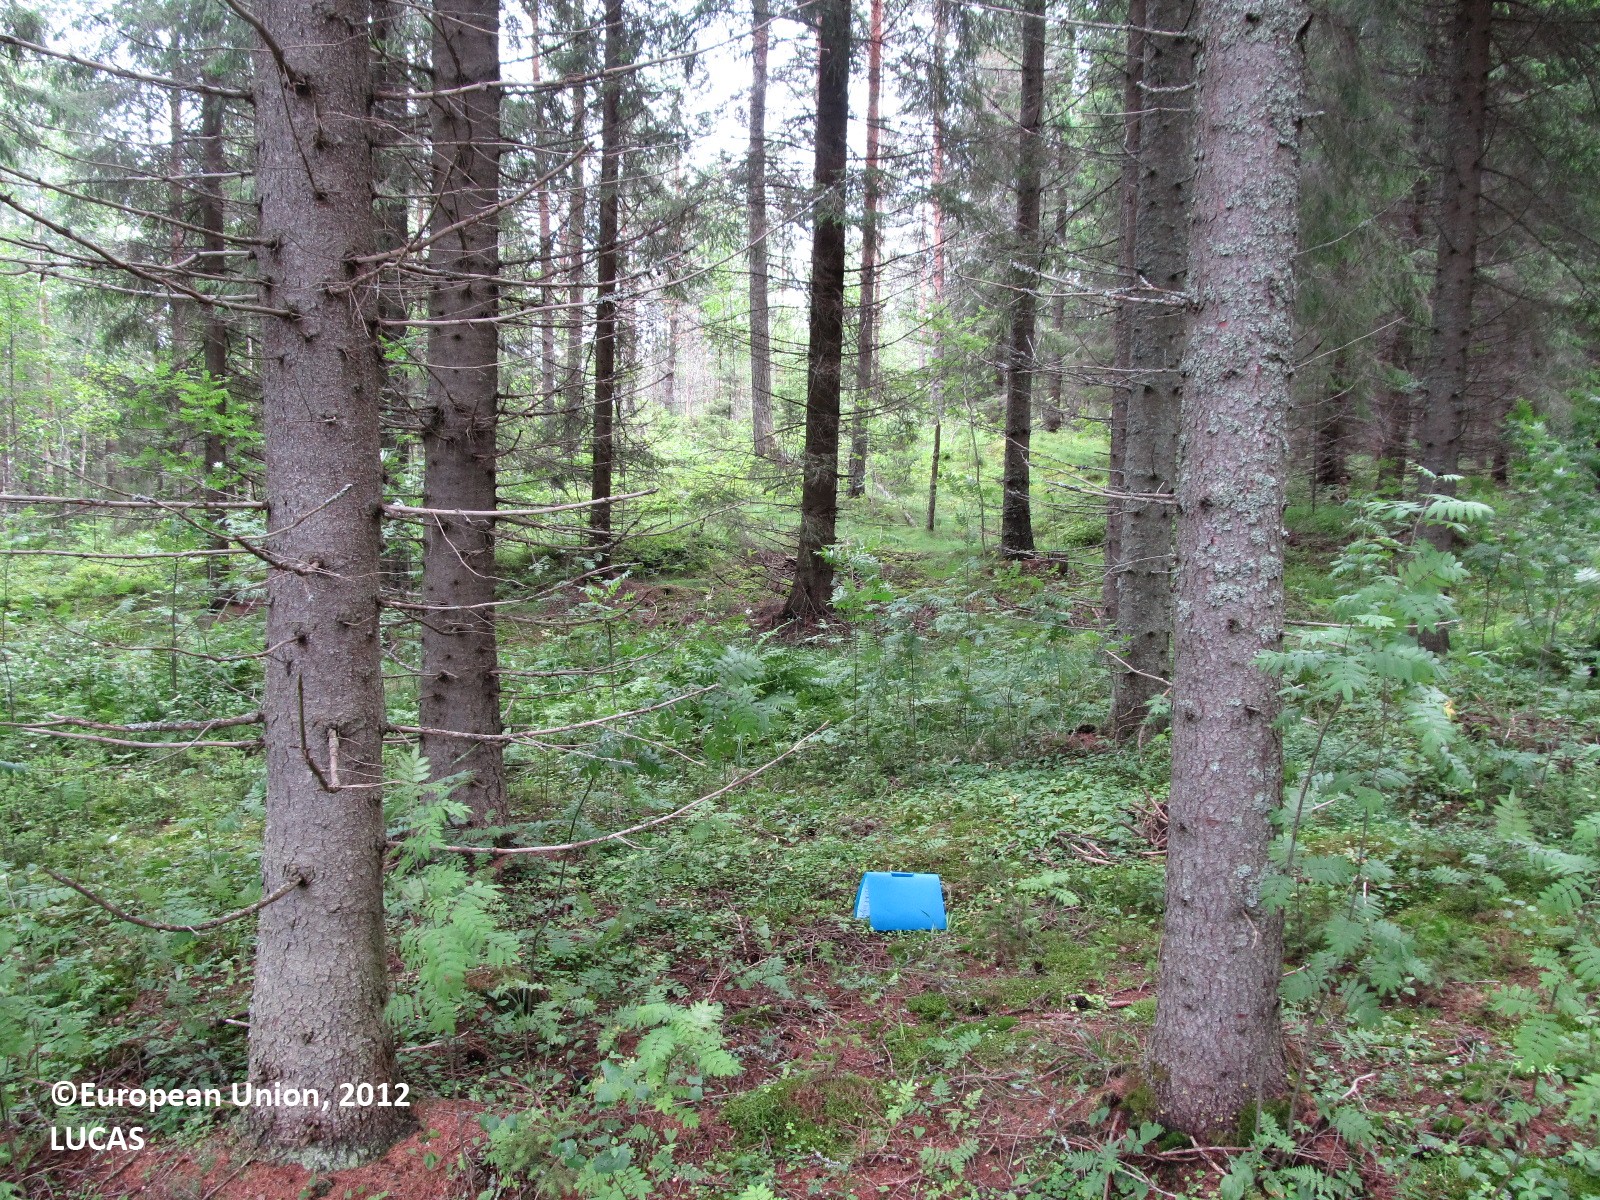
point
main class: Woodland
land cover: Spruce dominated coniferous woodland
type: boreal forest
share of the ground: 50 - 75 %
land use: Forestry
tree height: > 5 m
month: July
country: FI
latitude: 61.8989
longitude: 29.0499
